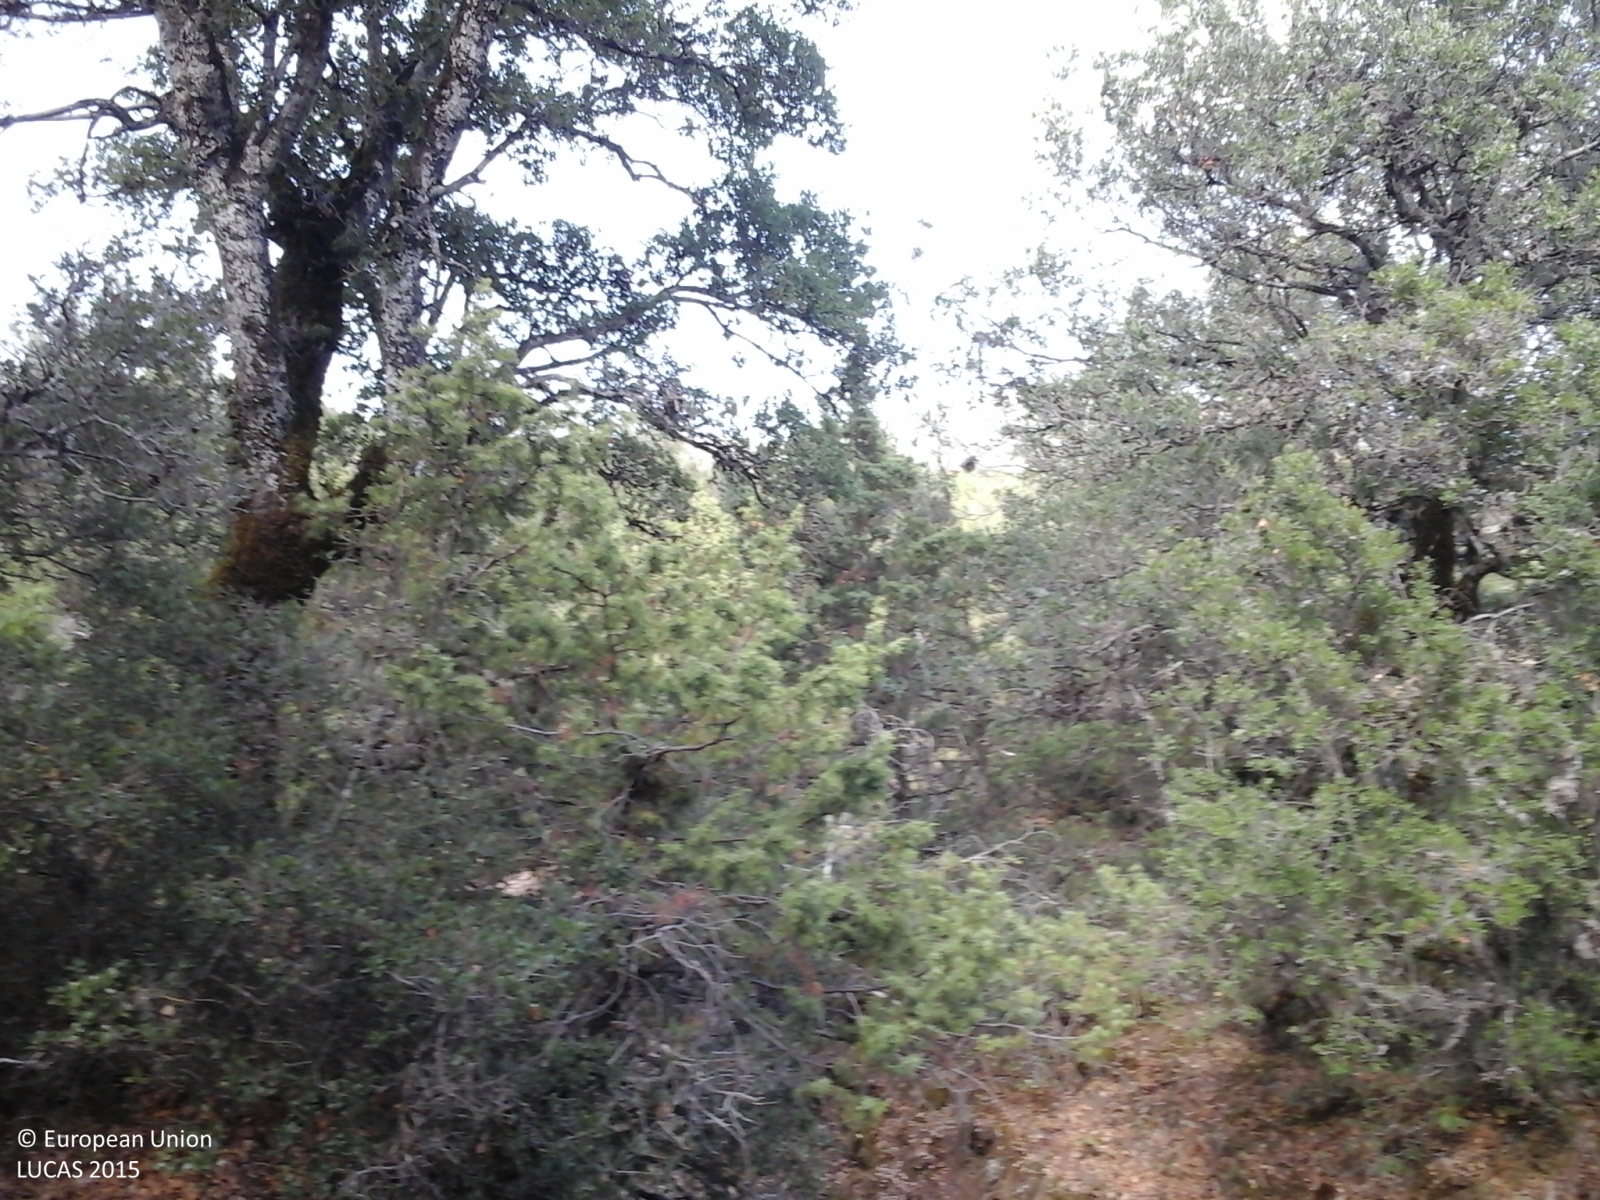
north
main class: Woodland
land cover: Broadleaved woodland
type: broadleaved evergreen forest
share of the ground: > 75 %
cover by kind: broadleaved forest trees 80 %, shrubs 10 %, herbaceous plants 5 %, unconsolidated bare surface 5 %
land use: Forestry
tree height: > 5 m
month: September
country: GR
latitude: 39.7399
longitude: 20.9840
